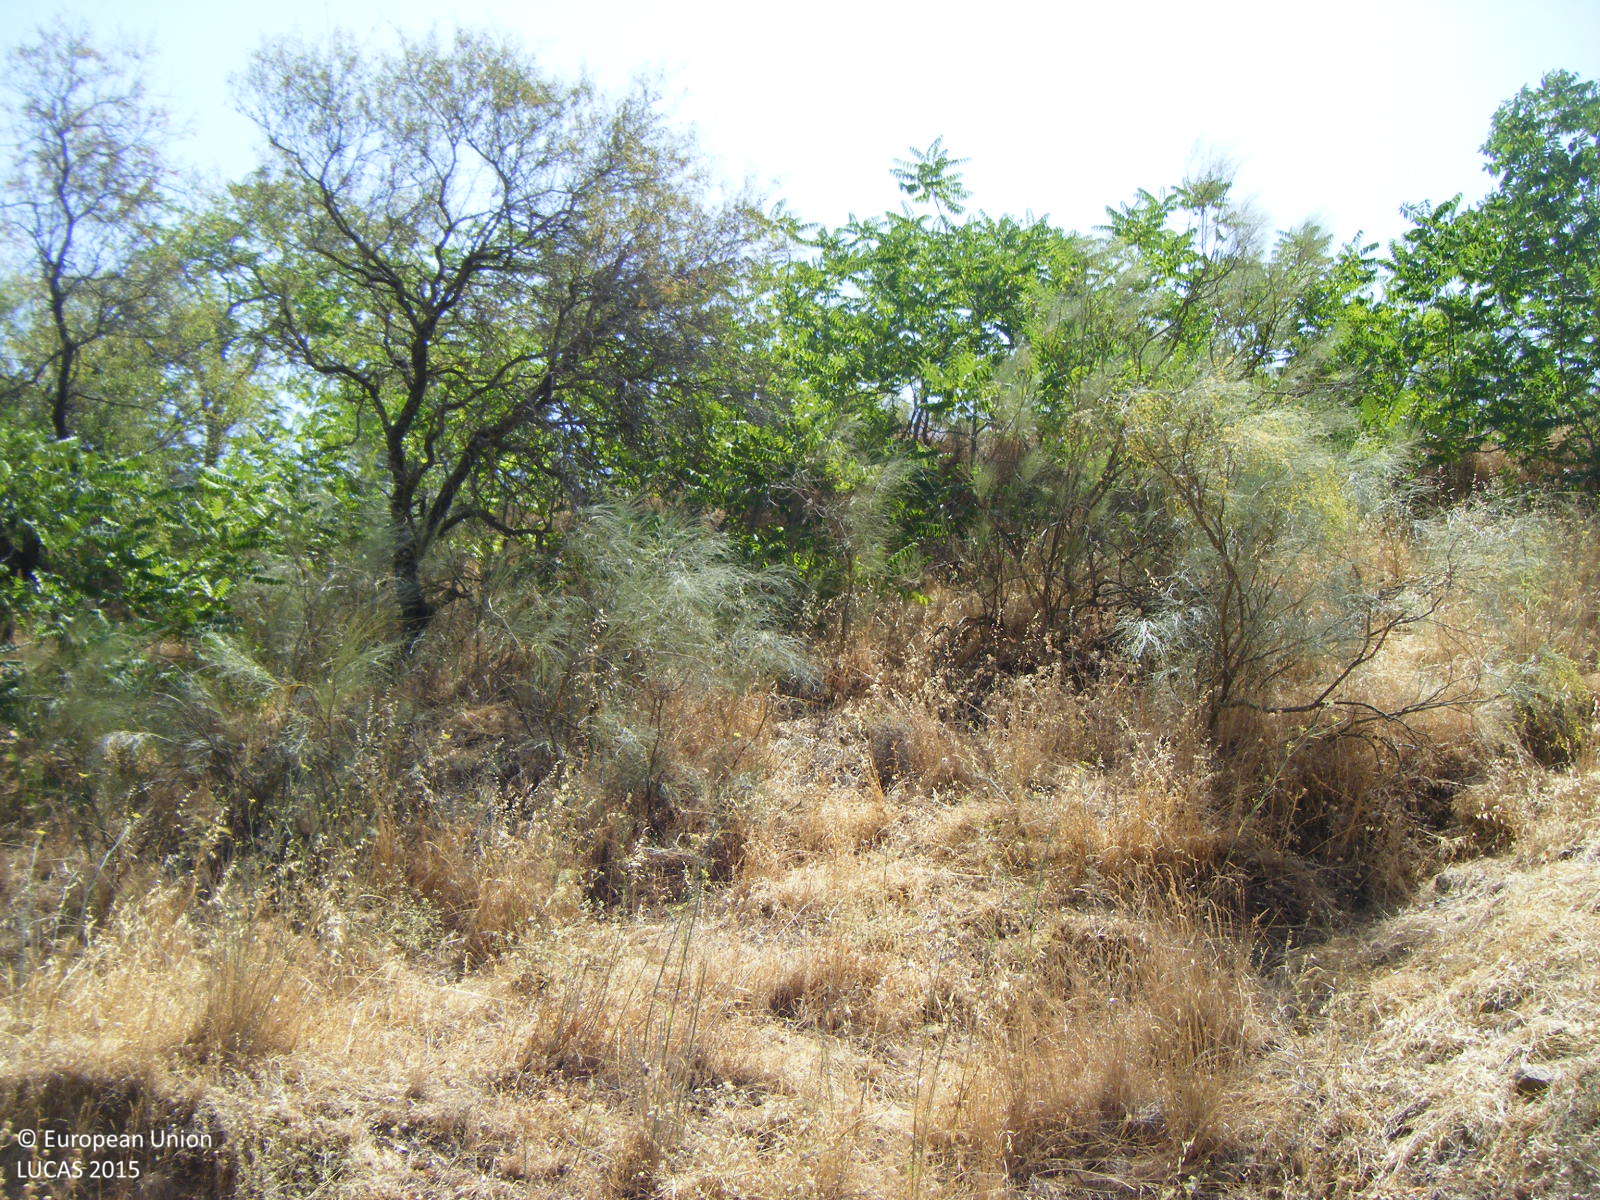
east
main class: Grassland
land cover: Grassland without tree/shrub cover
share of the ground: 50 - 75 %
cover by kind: herbaceous plants 70 %, unconsolidated bare surface 30 %
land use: Semi-natural and natural areas not in use
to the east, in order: Grassland without tree/shrub cover; Shrubland without tree cover; Paved roads, cycling and walking lanes; Shrubland without tree cover; Olive groves; Shrubland without tree cover; Paved roads, cycling and walking lanes; Shrubland without tree cover; Olive groves; Lines of trees; Rivers and streams; Lines of trees; Olive groves
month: July
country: ES
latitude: 36.8930
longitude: -4.3441
